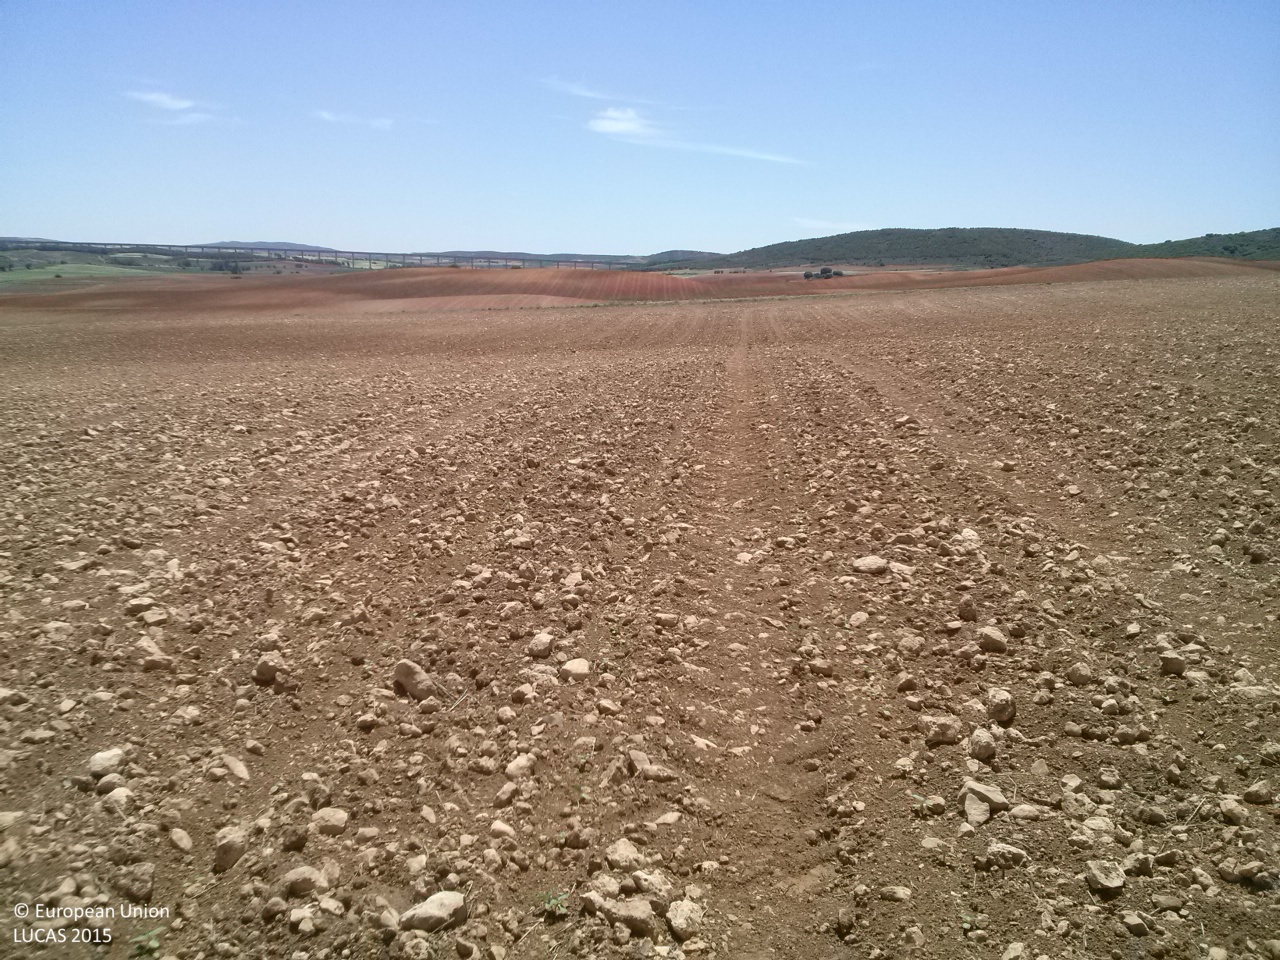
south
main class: Cropland
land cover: Sunflower
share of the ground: < 10 %
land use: Agriculture (excluding fallow land and kitchen gardens)
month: May
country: ES
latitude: 40.0993
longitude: -2.8206
